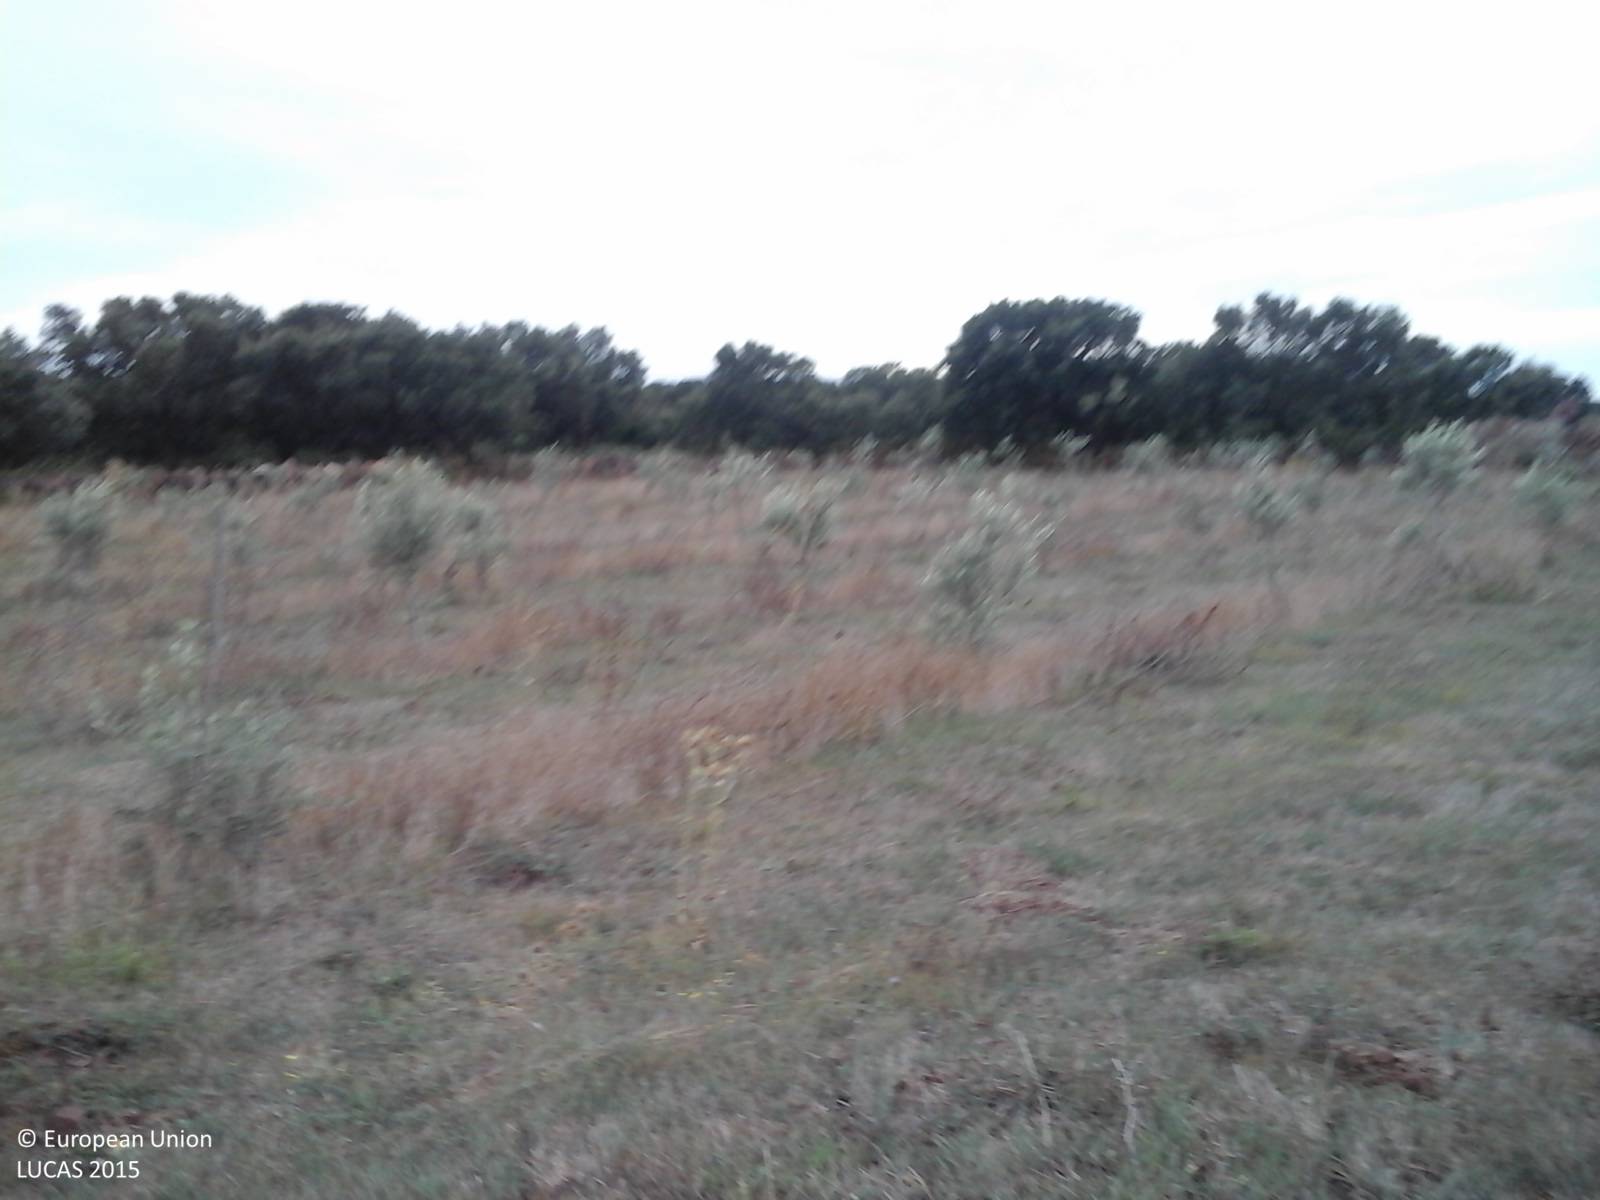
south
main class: Cropland
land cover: Olive groves
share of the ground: 10 - 25 %
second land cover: Grassland without tree/shrub cover
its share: > 75 %
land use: Agriculture (excluding fallow land and kitchen gardens)
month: September
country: IT
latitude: 40.2575
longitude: 8.6081
